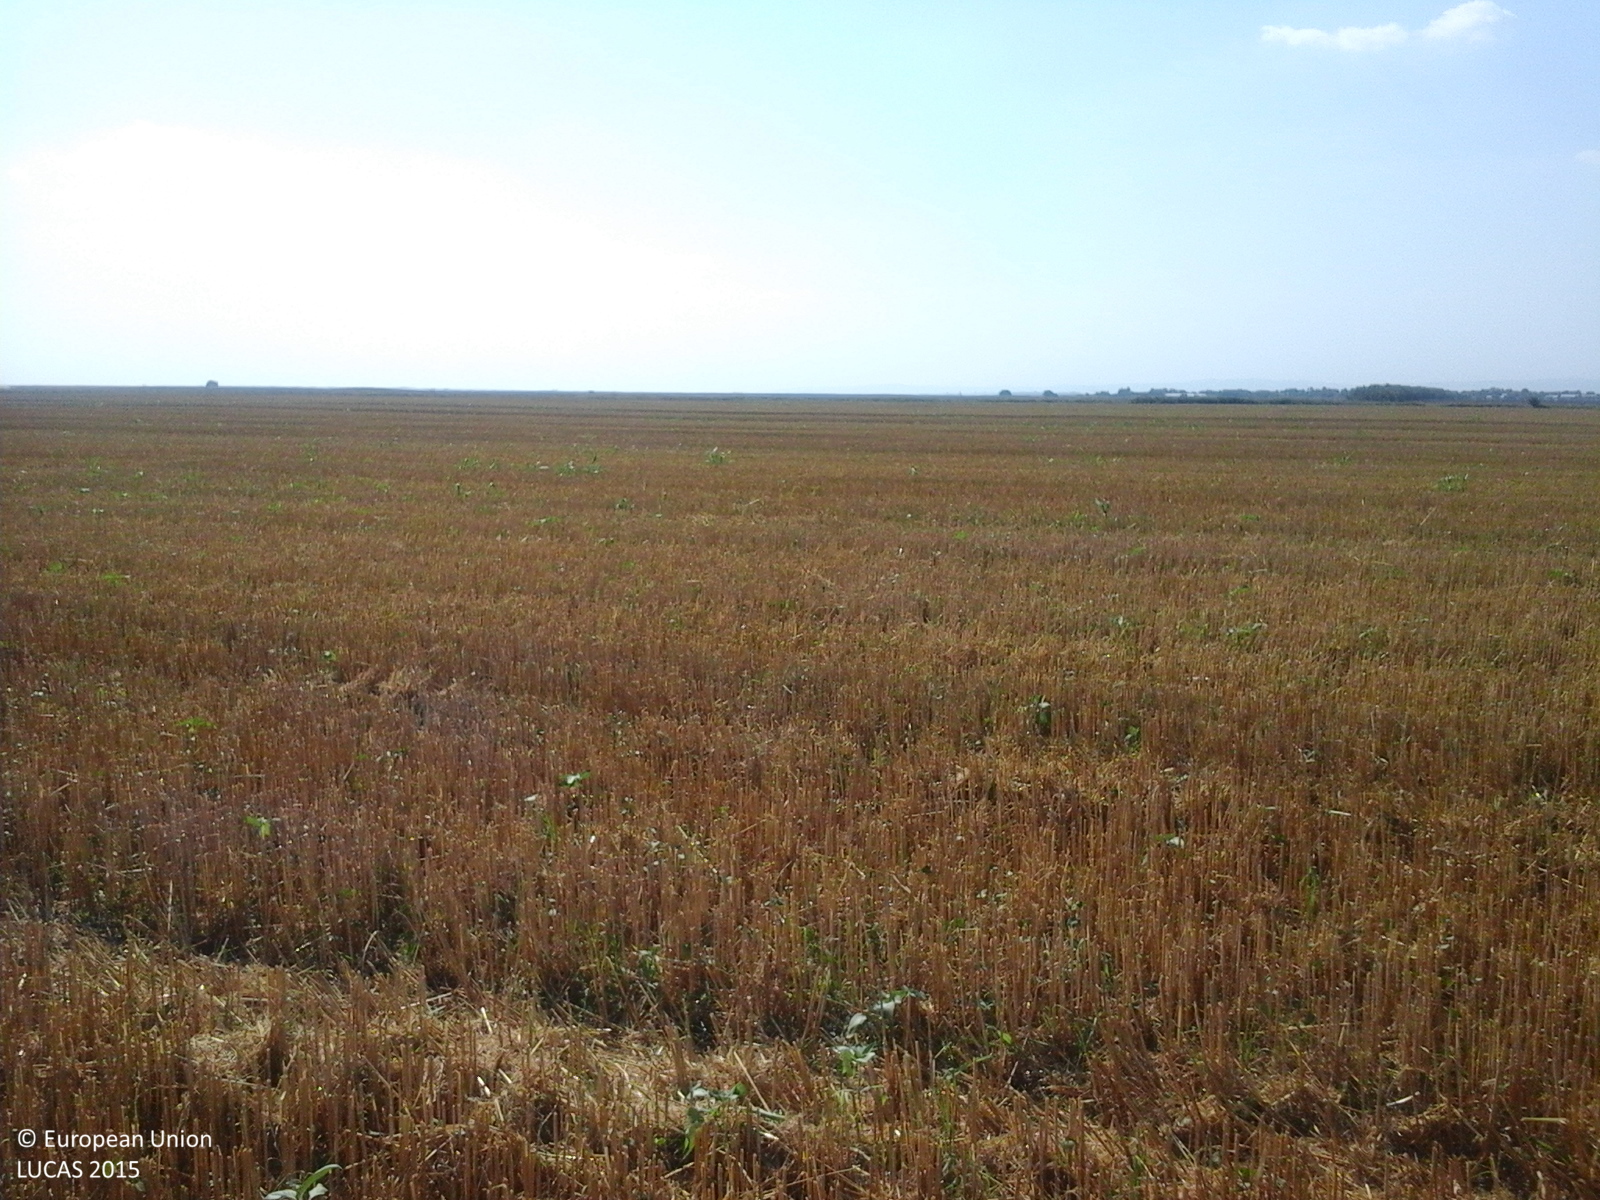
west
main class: Cropland
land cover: Durum wheat
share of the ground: > 75 %
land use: Agriculture (excluding fallow land and kitchen gardens)
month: July
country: RO
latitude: 44.8920
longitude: 26.6216
